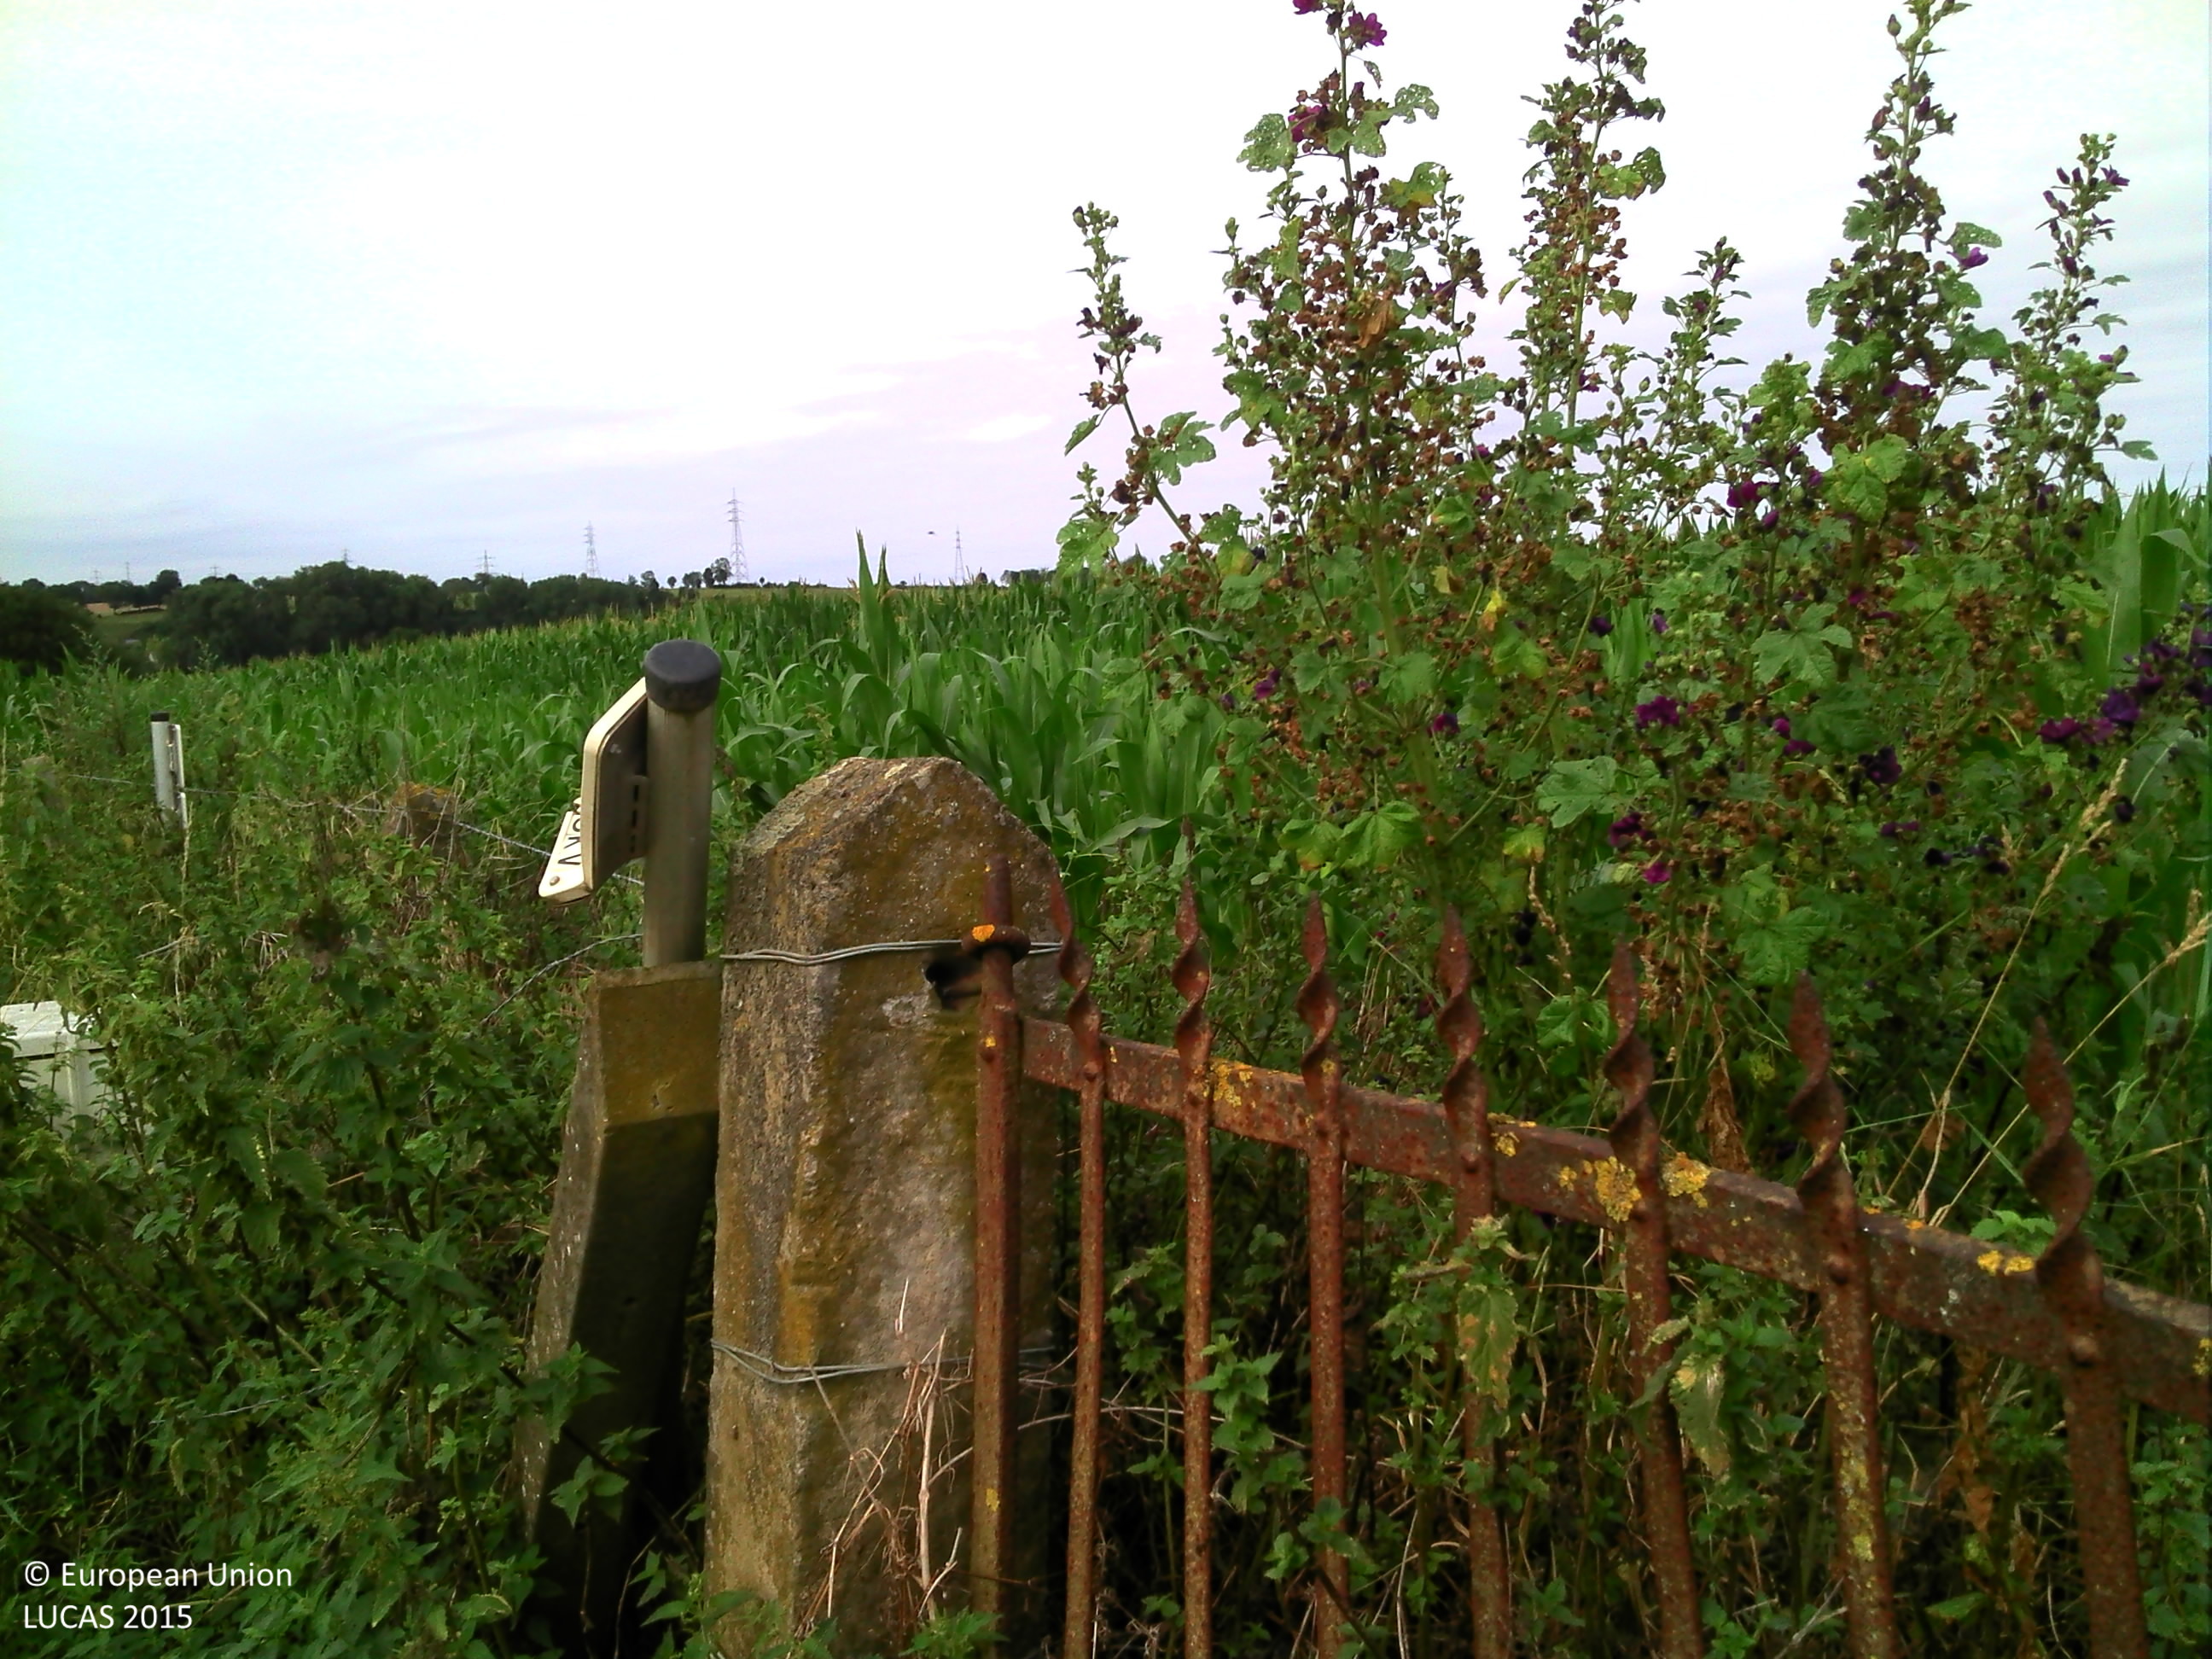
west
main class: Cropland
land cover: Maize
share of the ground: > 75 %
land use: Agriculture (excluding fallow land and kitchen gardens)
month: July
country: BE
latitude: 50.7526
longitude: 5.7321
